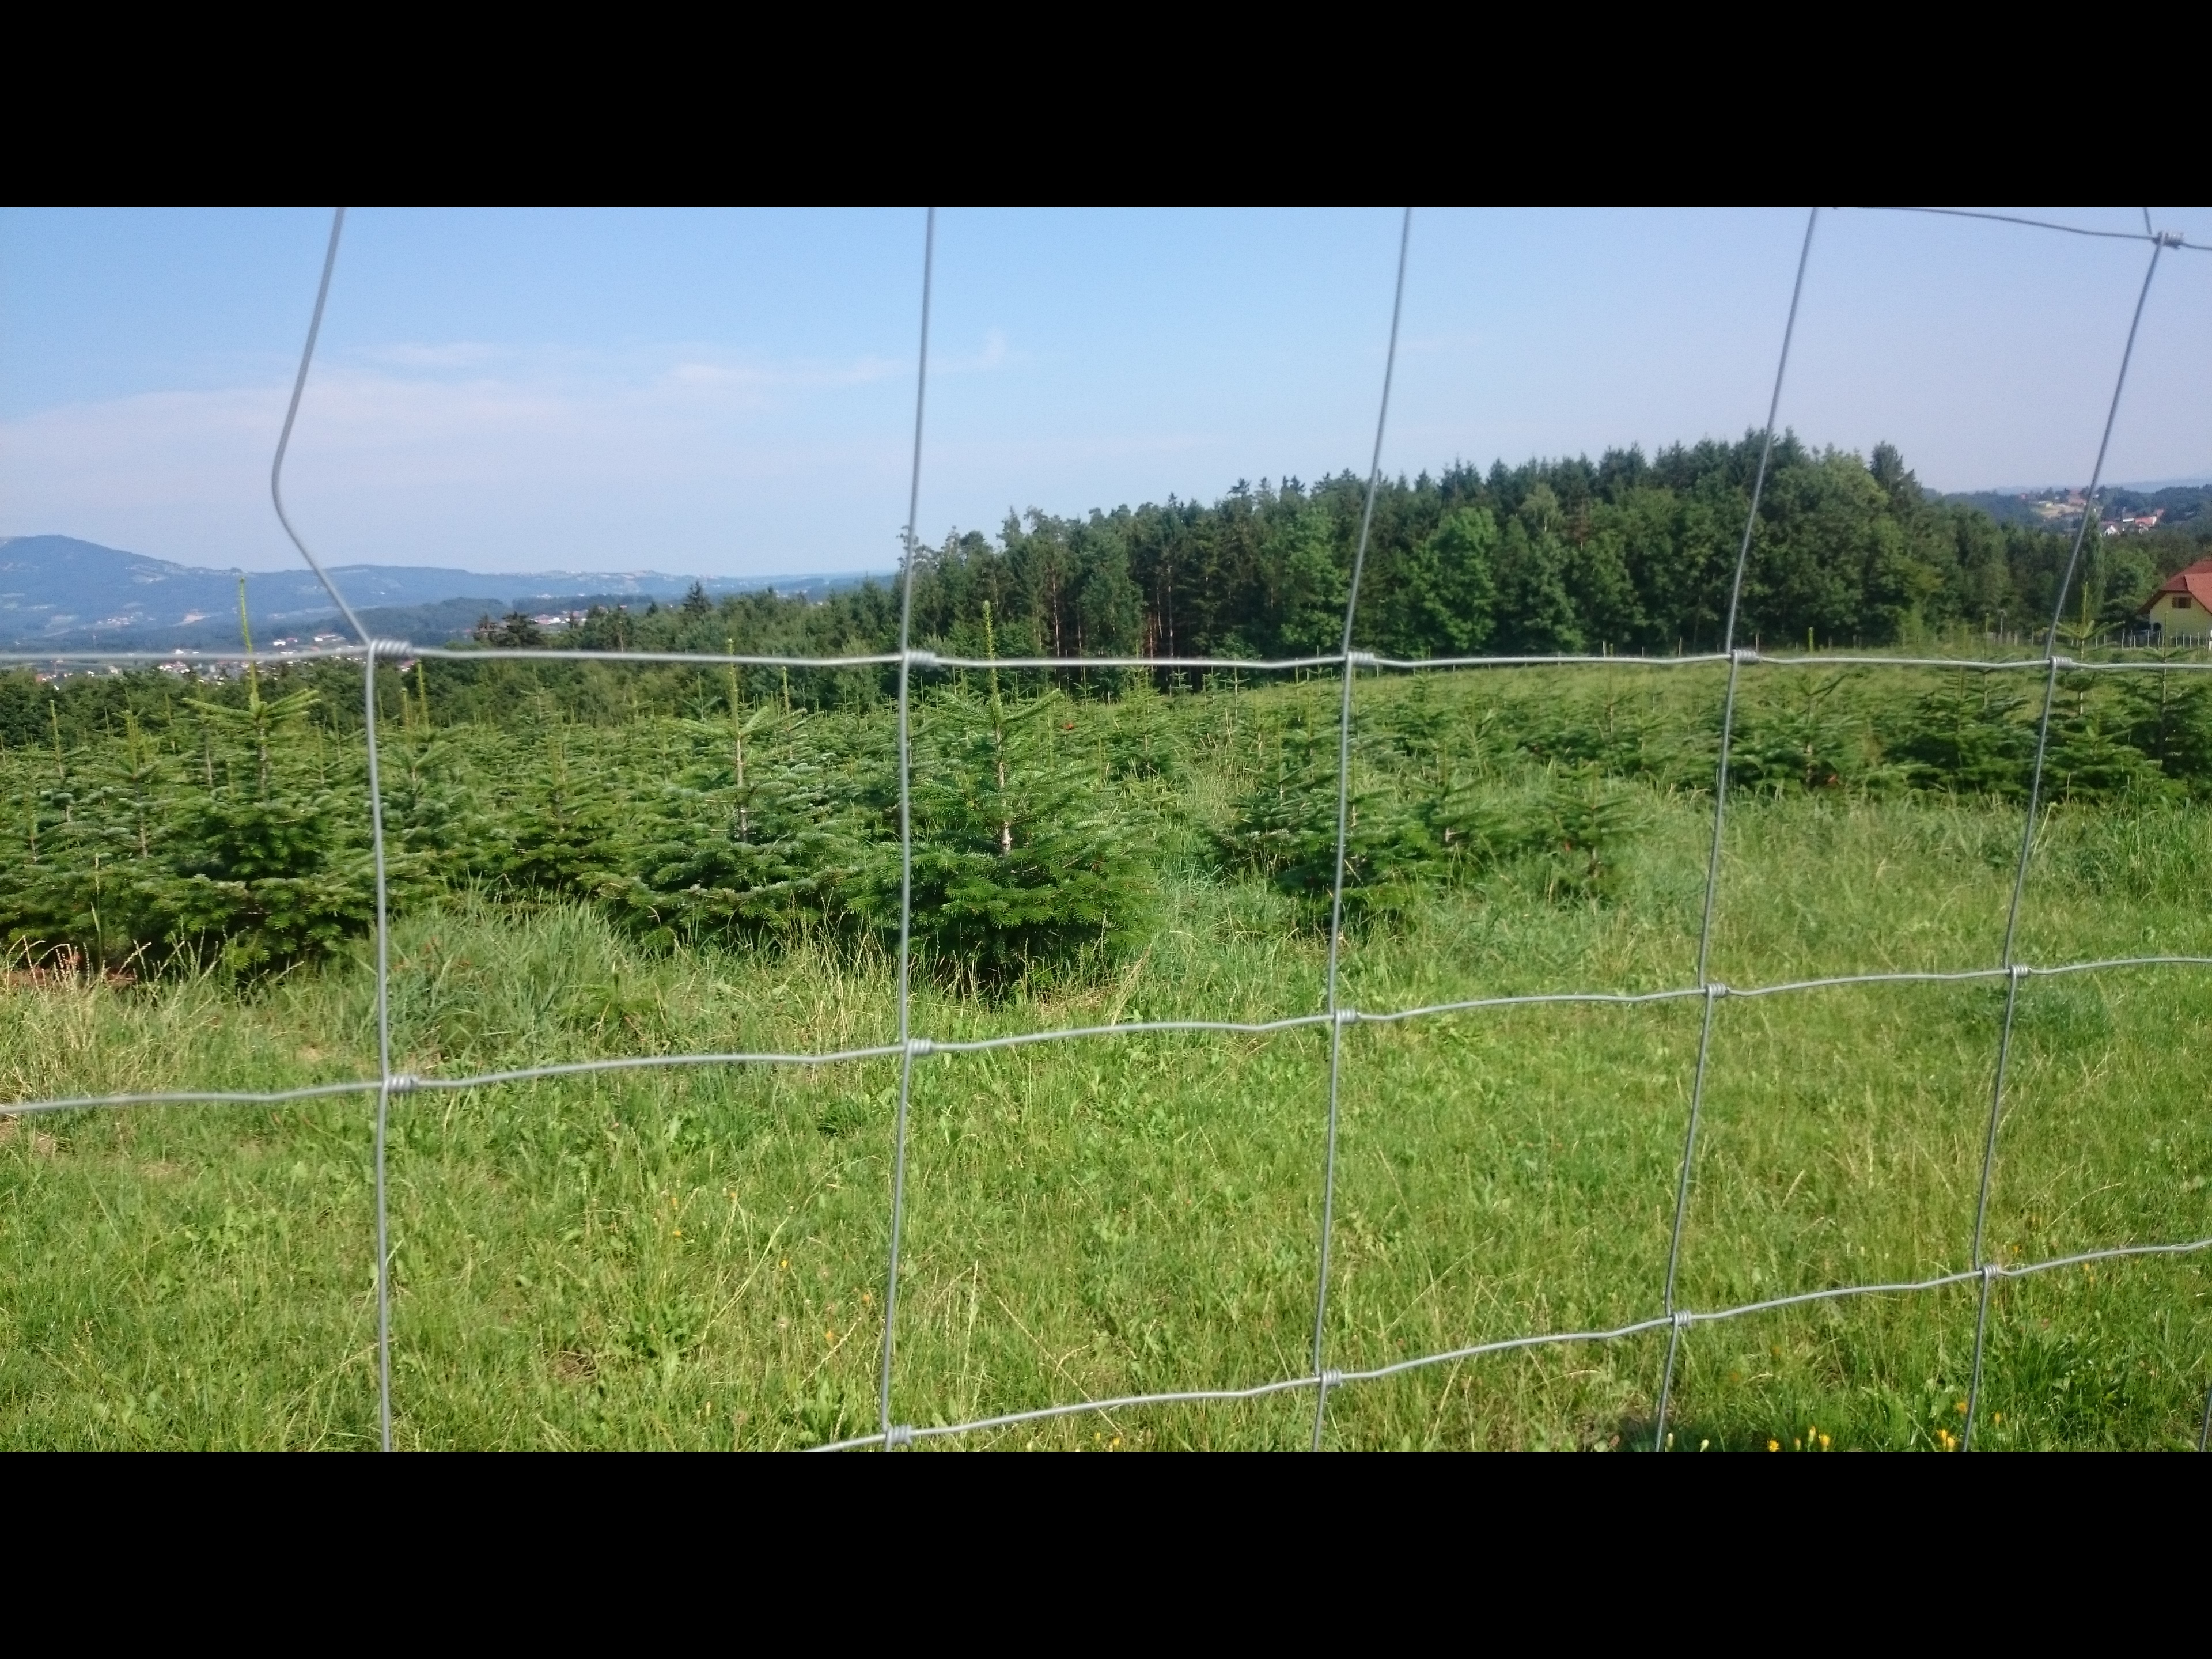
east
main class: Woodland
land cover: Other coniferous woodland
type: hemiboreal forest and nemoral coniferous forest and mixed broadleaved-coniferous forest
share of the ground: 50 - 75 %
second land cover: Grassland without tree/shrub cover
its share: 25 - 50 %
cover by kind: coniferous forest trees 55 %, herbaceous plants 45 %
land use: Forestry
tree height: < 5 m
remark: Nursery
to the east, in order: Other coniferous woodland; Grassland without tree/shrub cover; Spruce dominated coniferous woodland; Fences; Grassland without tree/shrub cover; Broadleaved woodland
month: July
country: AT
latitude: 47.2146
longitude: 15.6122
